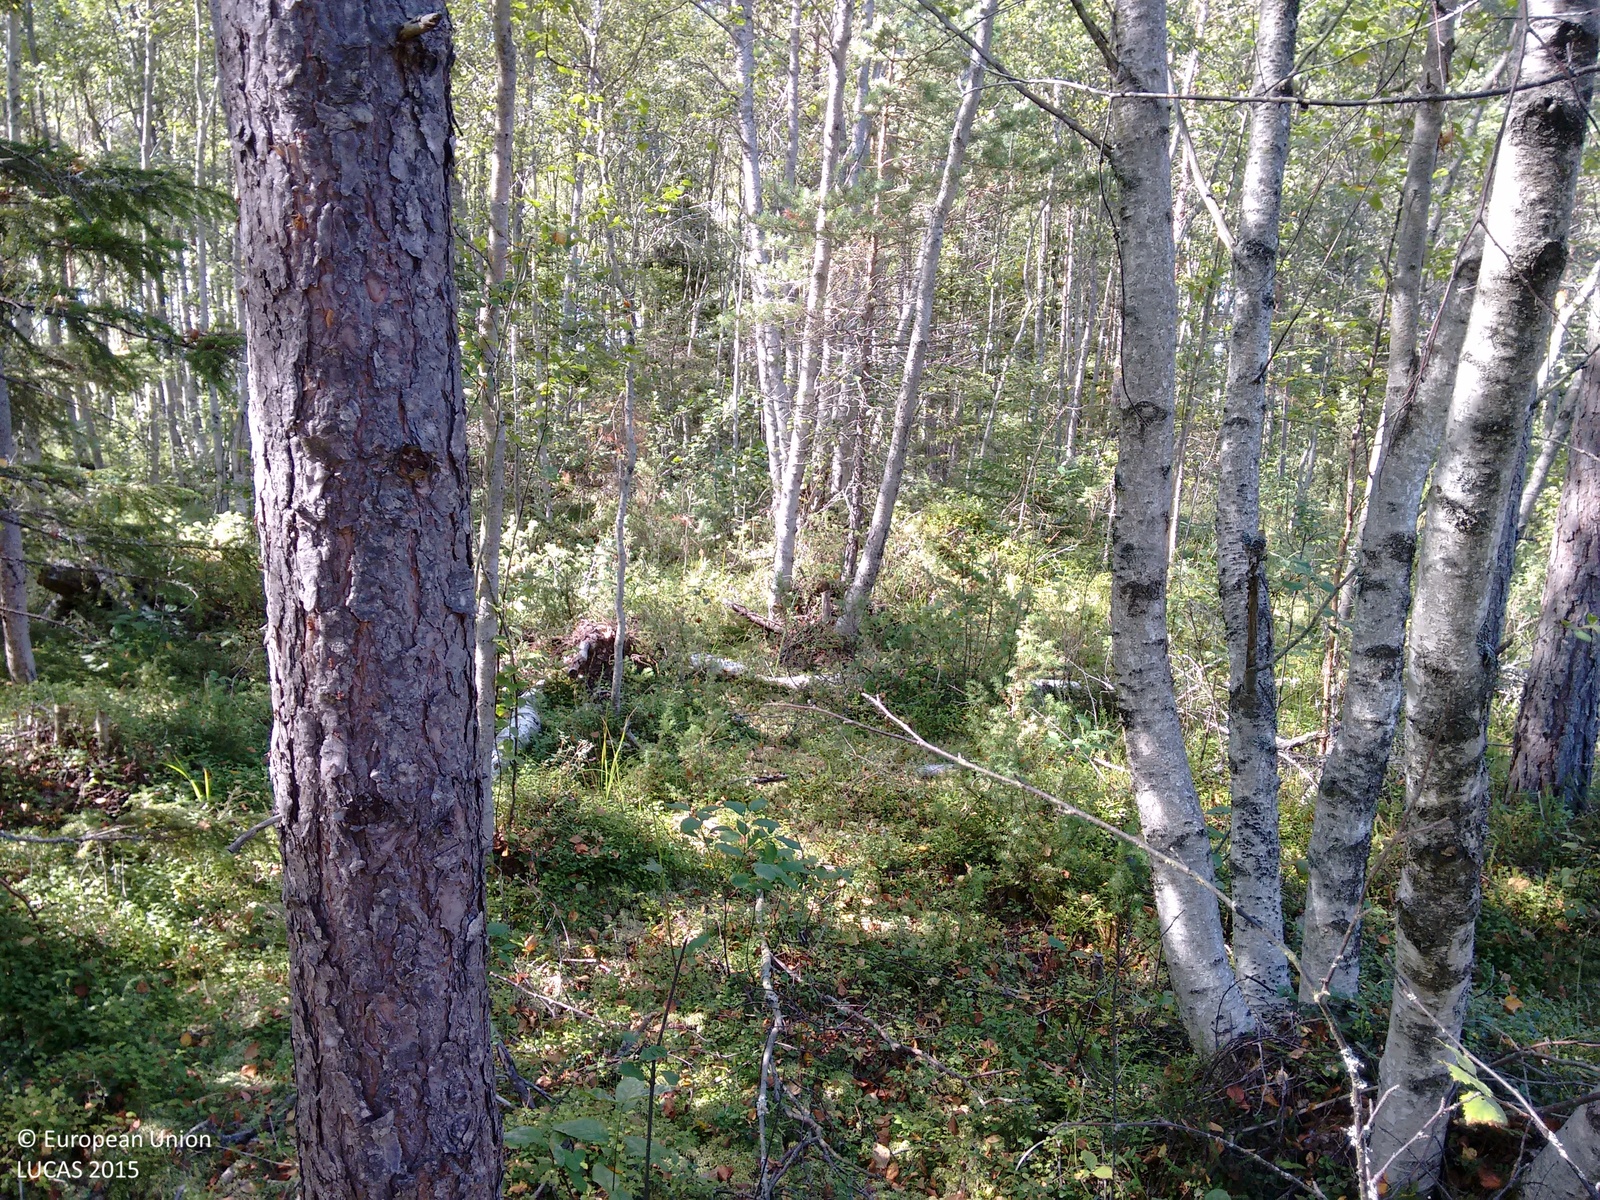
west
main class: Woodland
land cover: Pine dominated mixed woodland
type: hemiboreal forest and nemoral coniferous forest and mixed broadleaved-coniferous forest
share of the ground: > 75 %
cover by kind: coniferous forest trees 60 %, broadleaved forest trees 25 %, shrubs 5 %, herbaceous plants 5 %, lichens and mosses 5 %
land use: Forestry
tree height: > 5 m
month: August
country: FI
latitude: 60.2320
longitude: 19.6279
